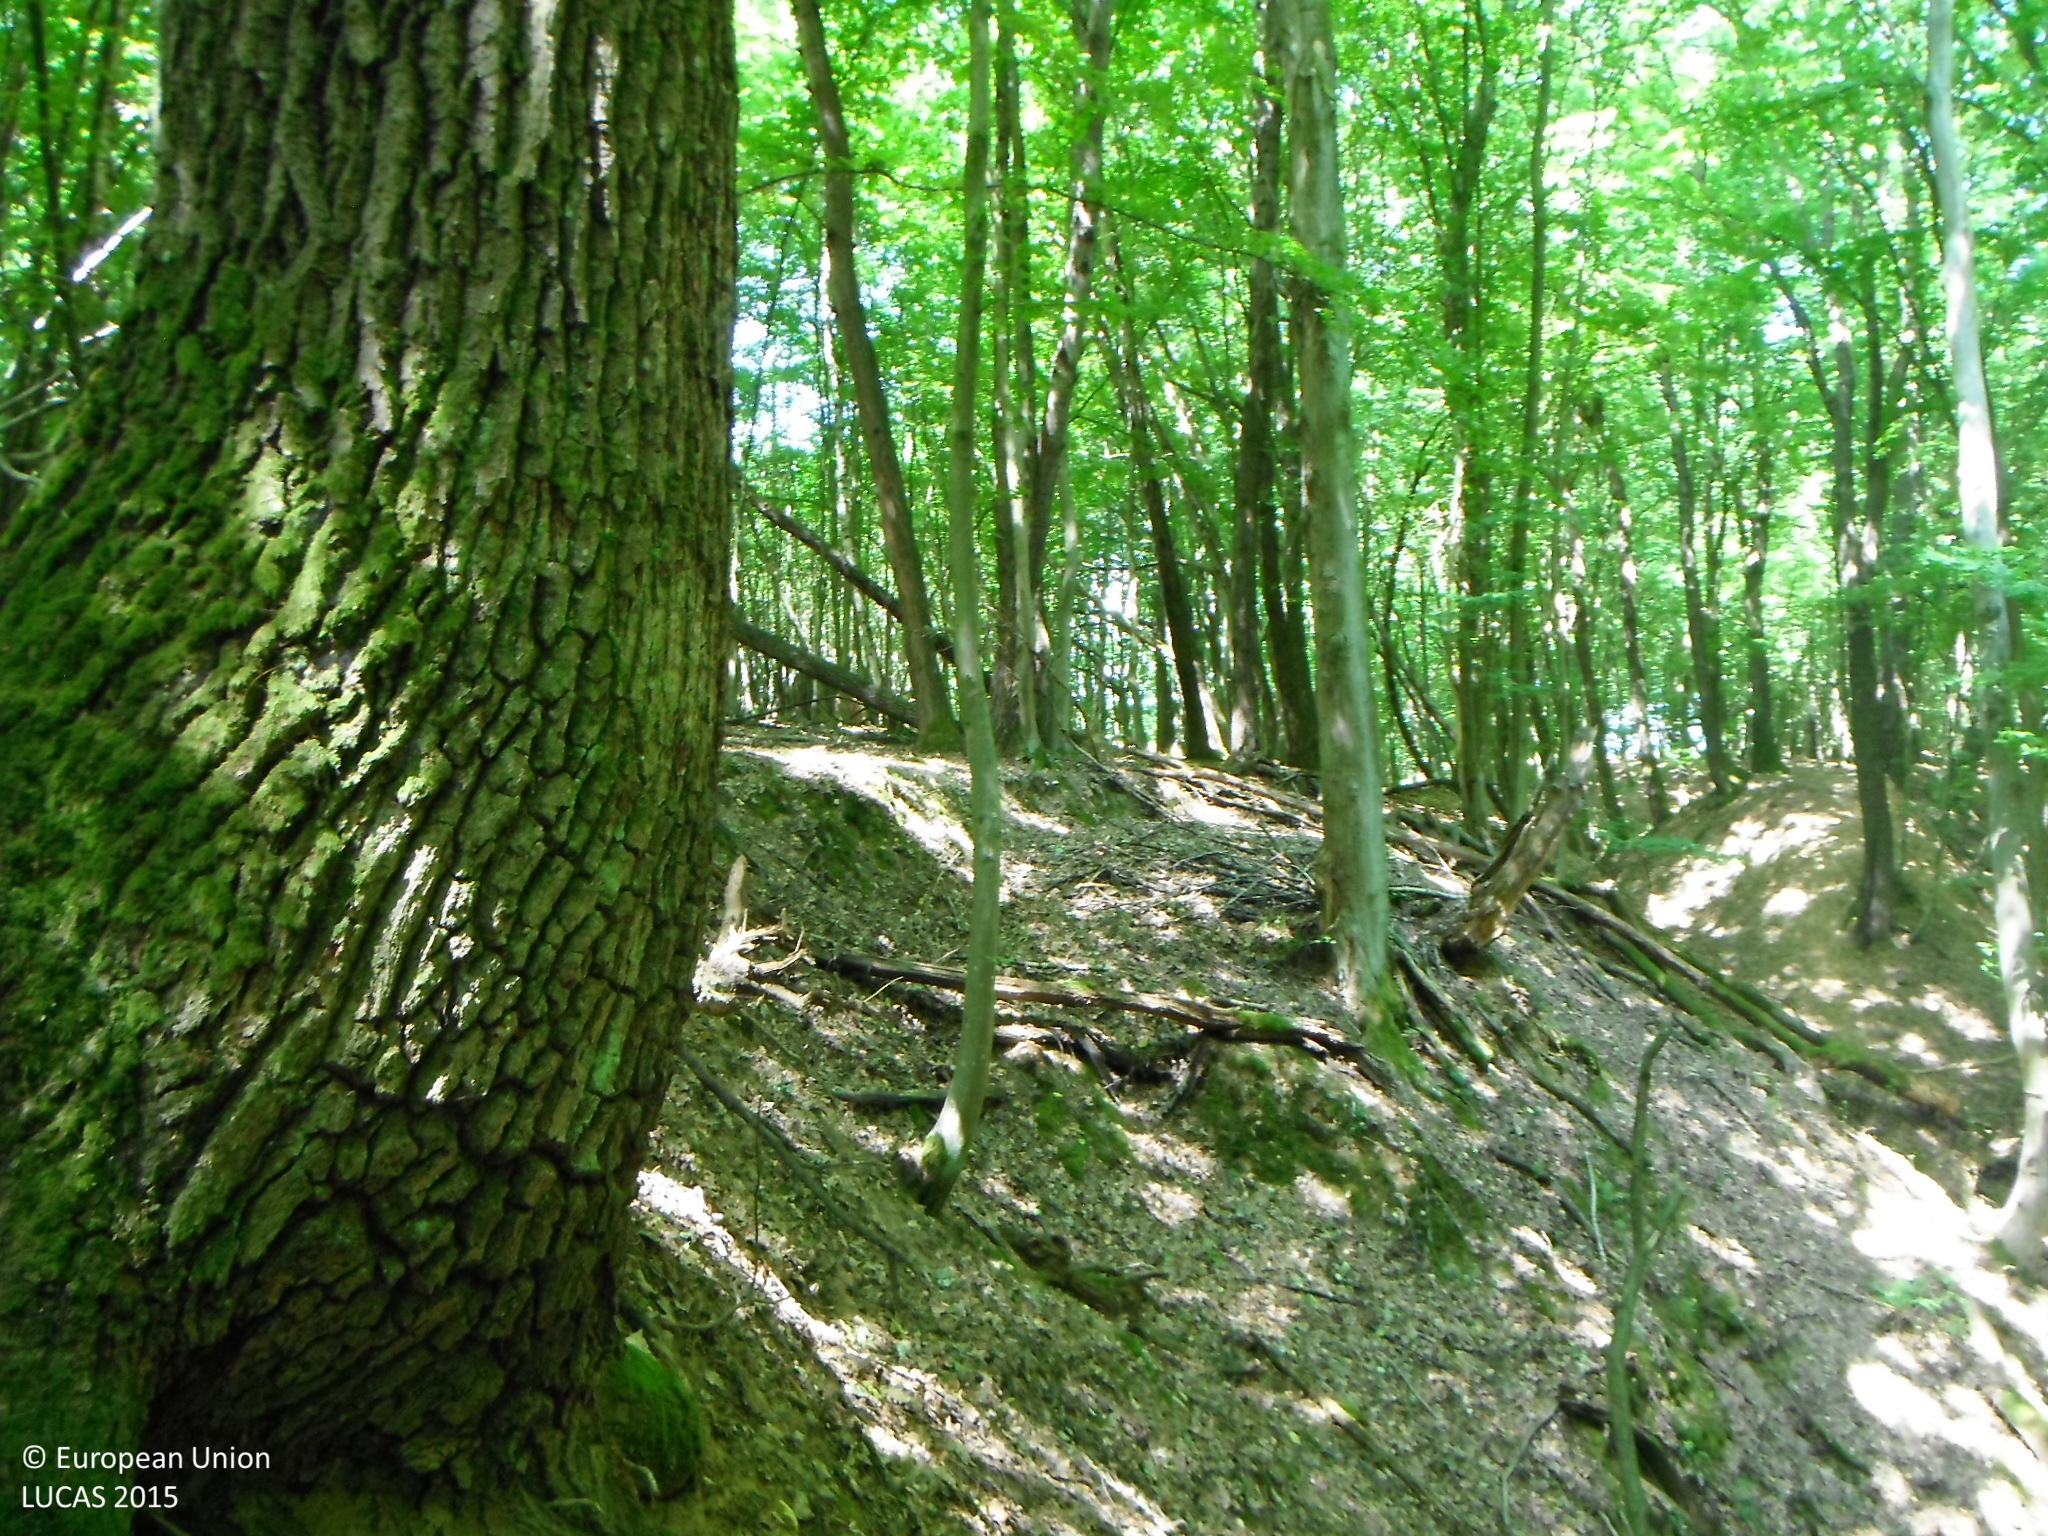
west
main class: Woodland
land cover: Broadleaved woodland
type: mesophytic deciduous forest
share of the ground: > 75 %
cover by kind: broadleaved forest trees 100 %
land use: Forestry
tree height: > 5 m
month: July
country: SK
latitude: 48.2484
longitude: 19.0569
